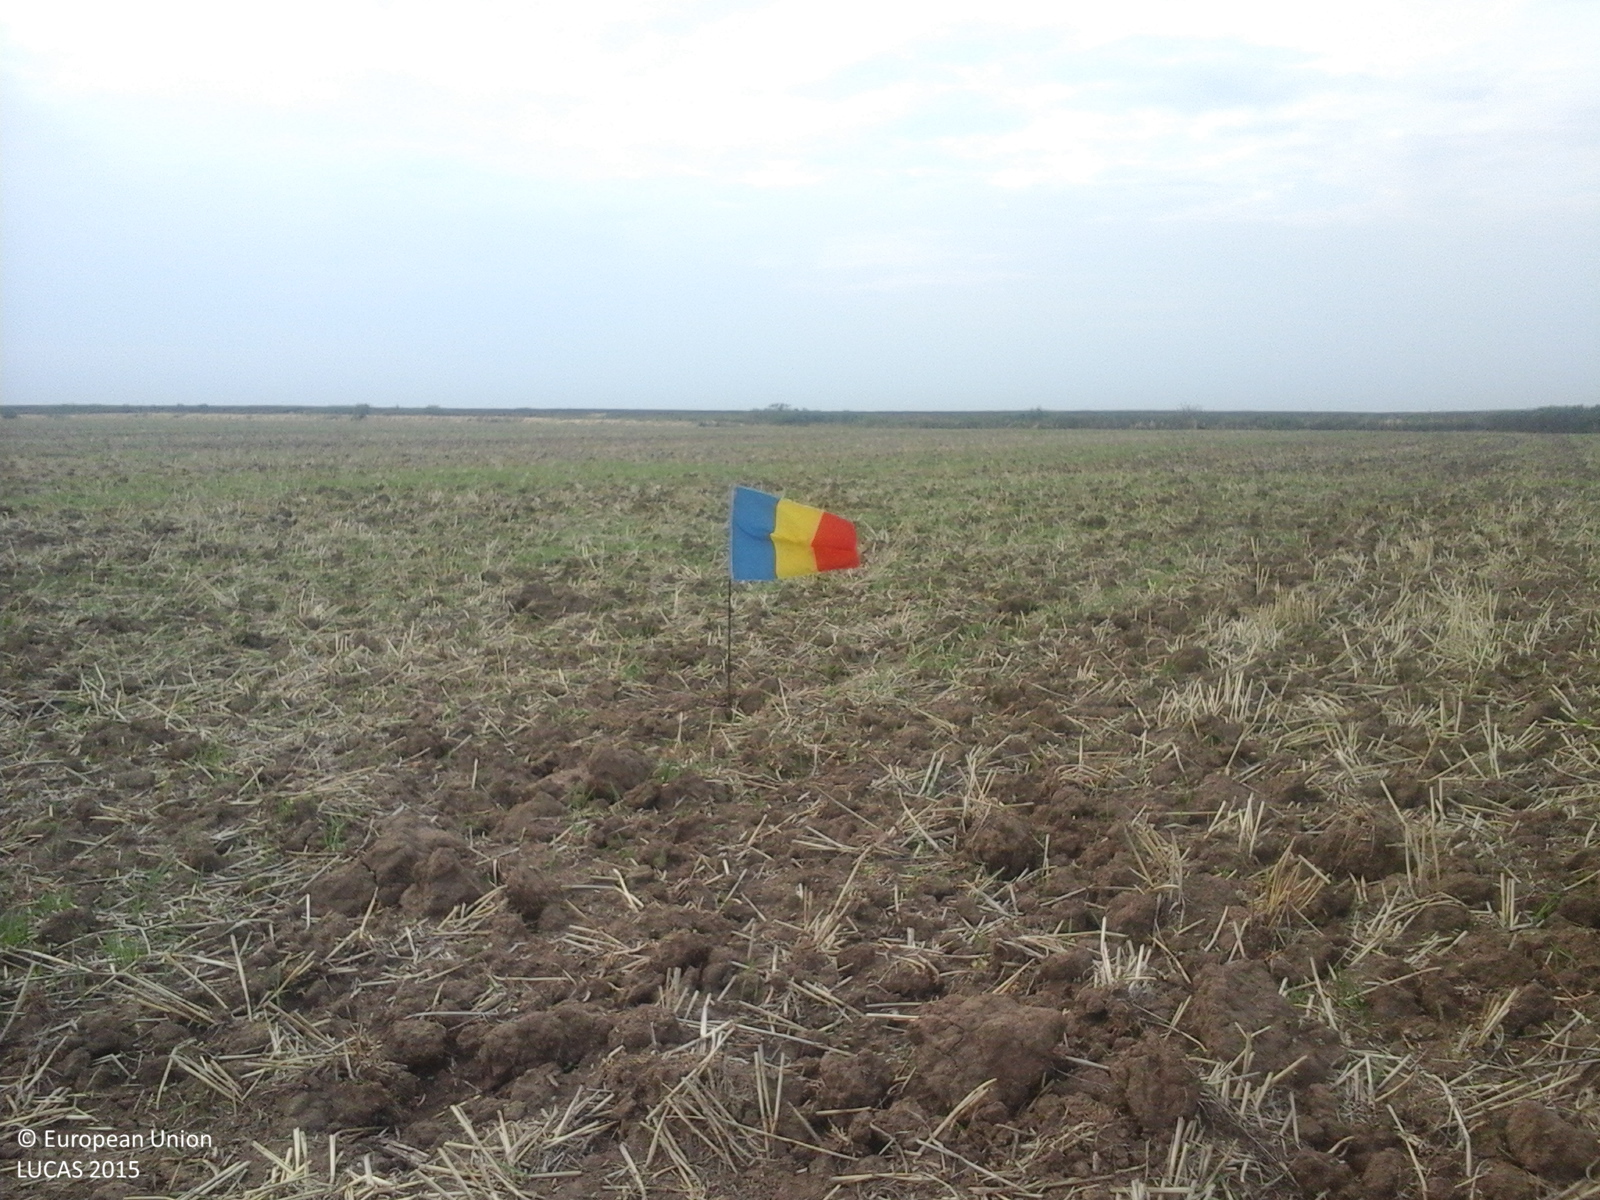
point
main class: Cropland
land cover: Durum wheat
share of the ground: < 10 %
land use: Agriculture (excluding fallow land and kitchen gardens)
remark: Harvested field
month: August
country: RO
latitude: 46.1832
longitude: 21.5015
